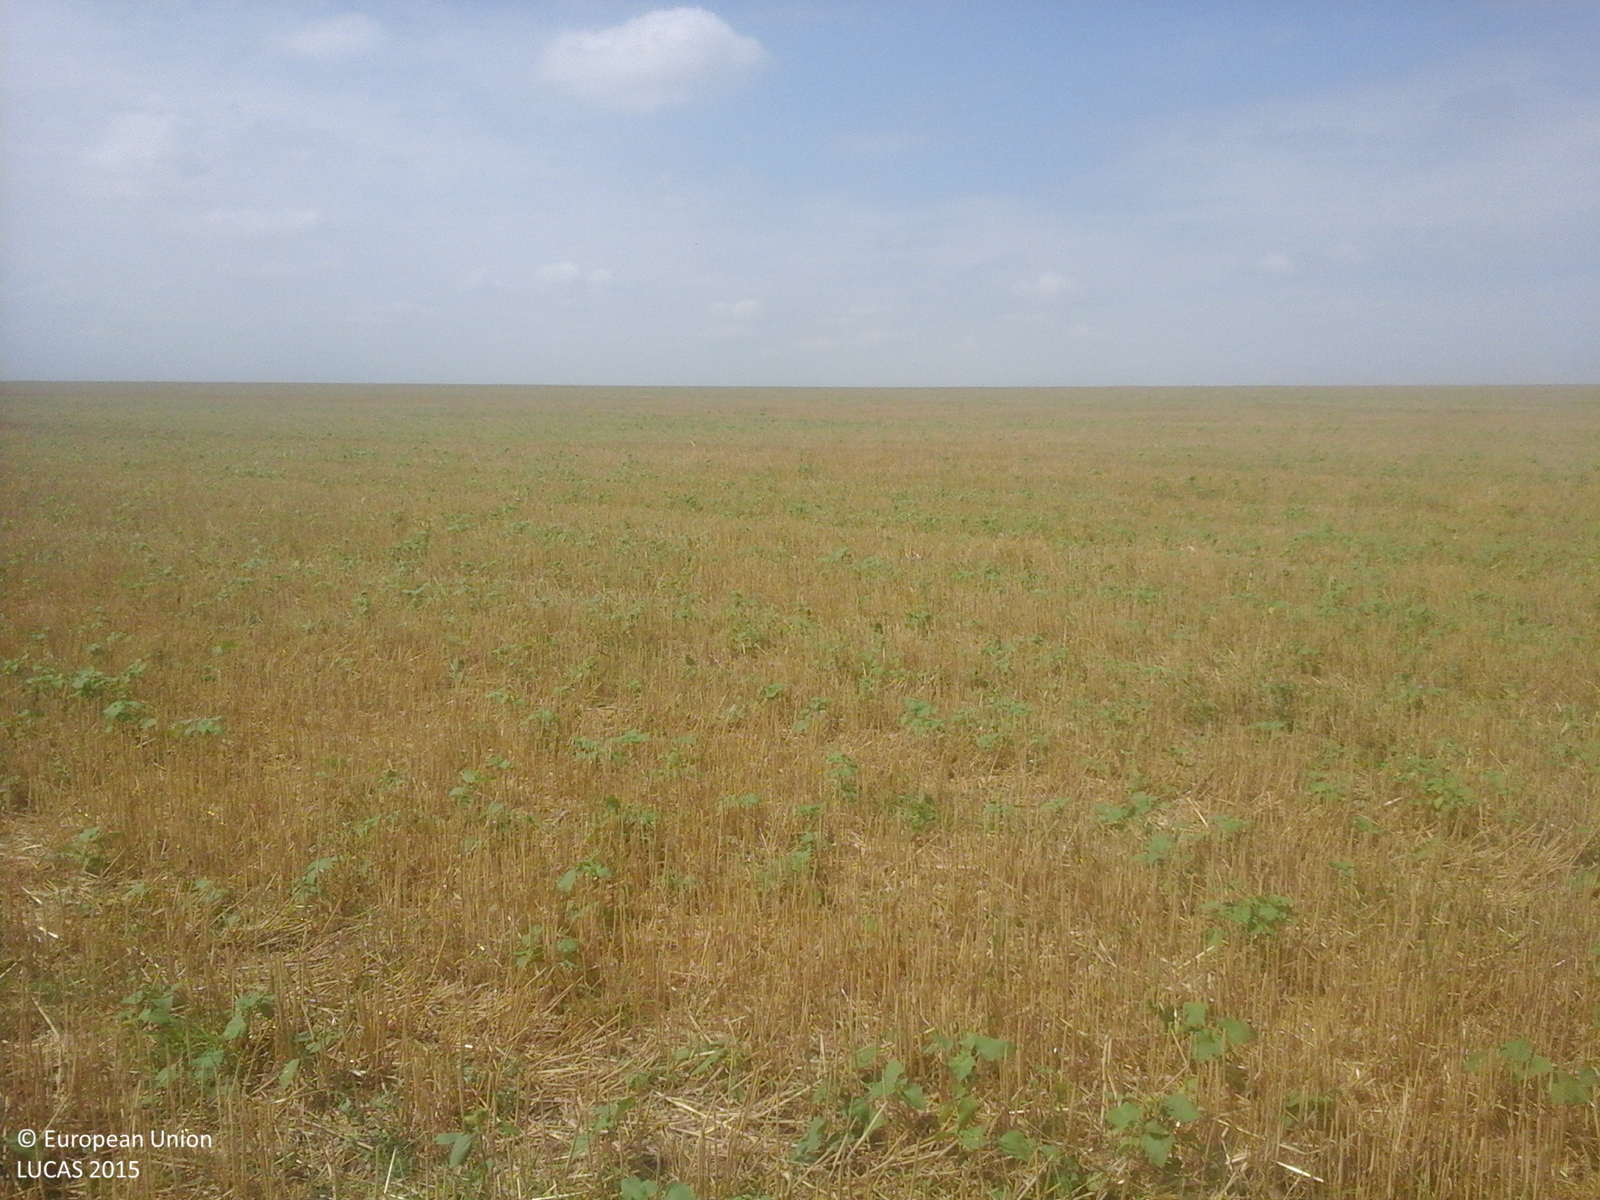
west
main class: Cropland
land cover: Common wheat
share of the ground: > 75 %
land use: Agriculture (excluding fallow land and kitchen gardens)
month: August
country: RO
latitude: 44.6724
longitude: 28.3479
